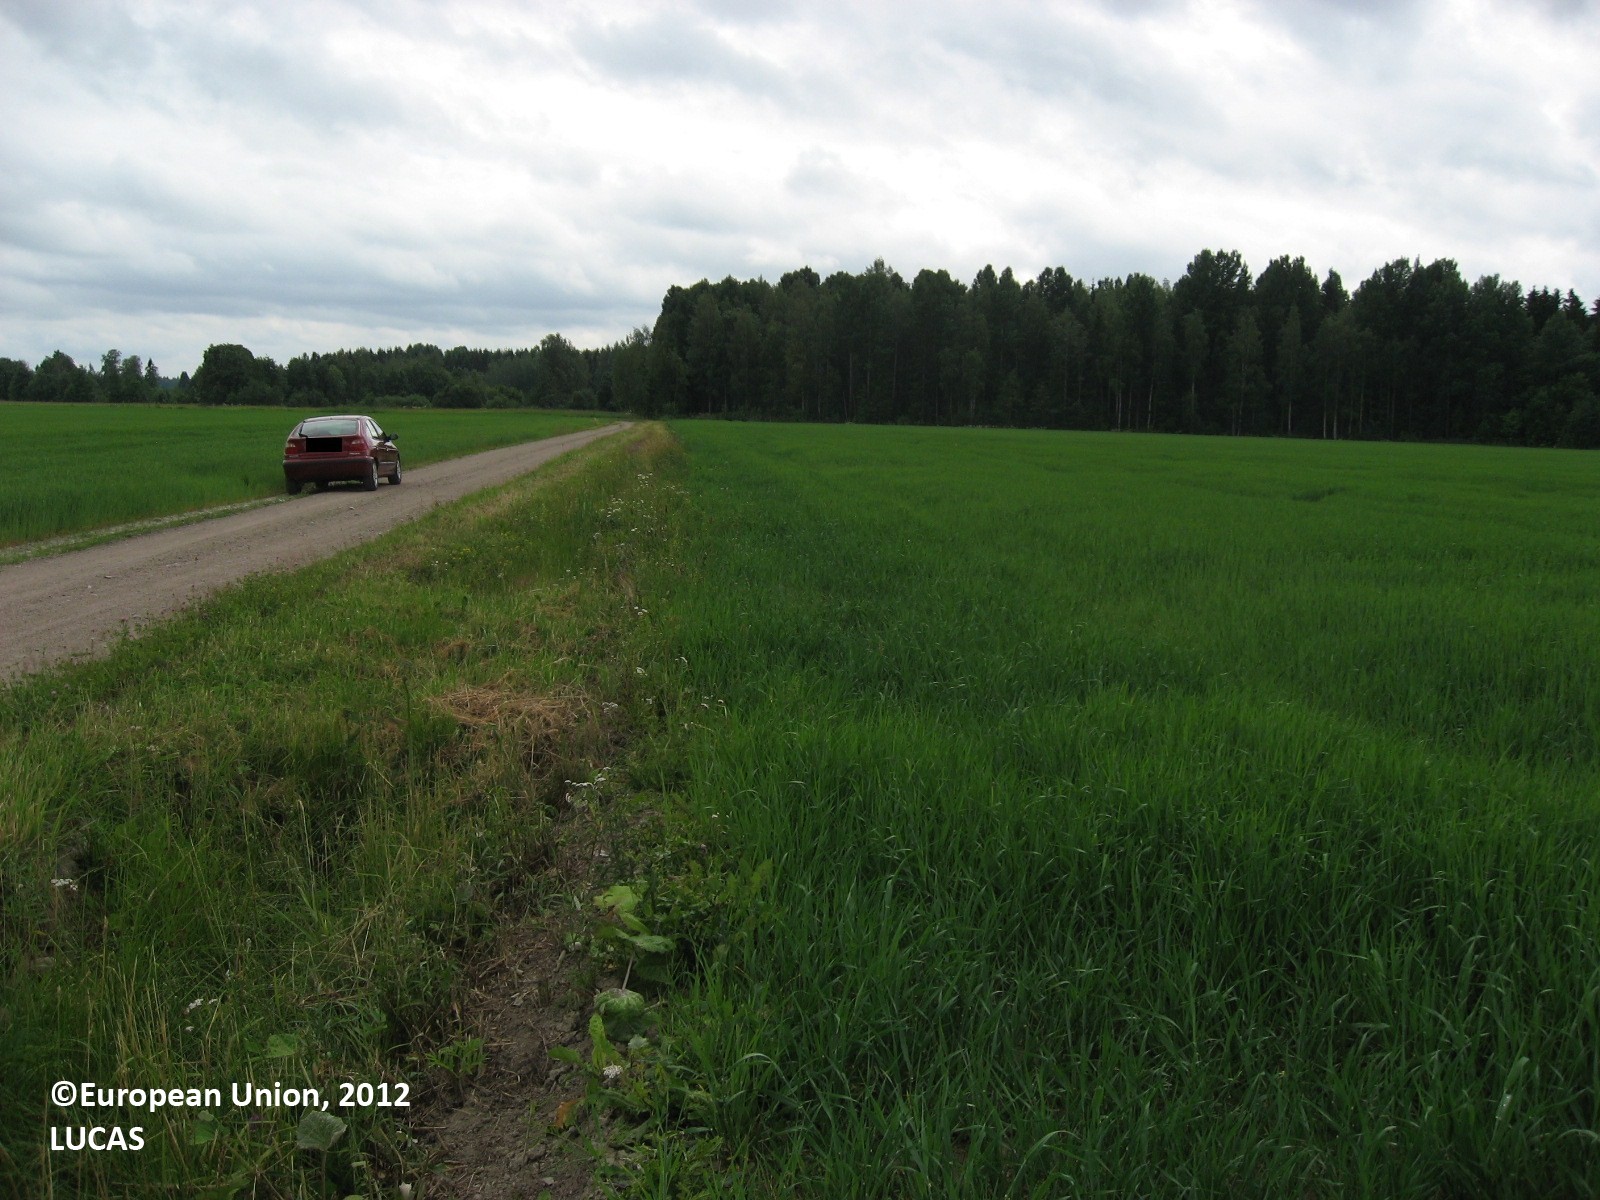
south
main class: Cropland
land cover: Barley
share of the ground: > 75 %
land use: Agriculture (excluding fallow land and kitchen gardens)
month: July
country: FI
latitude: 60.9204
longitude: 25.6416
